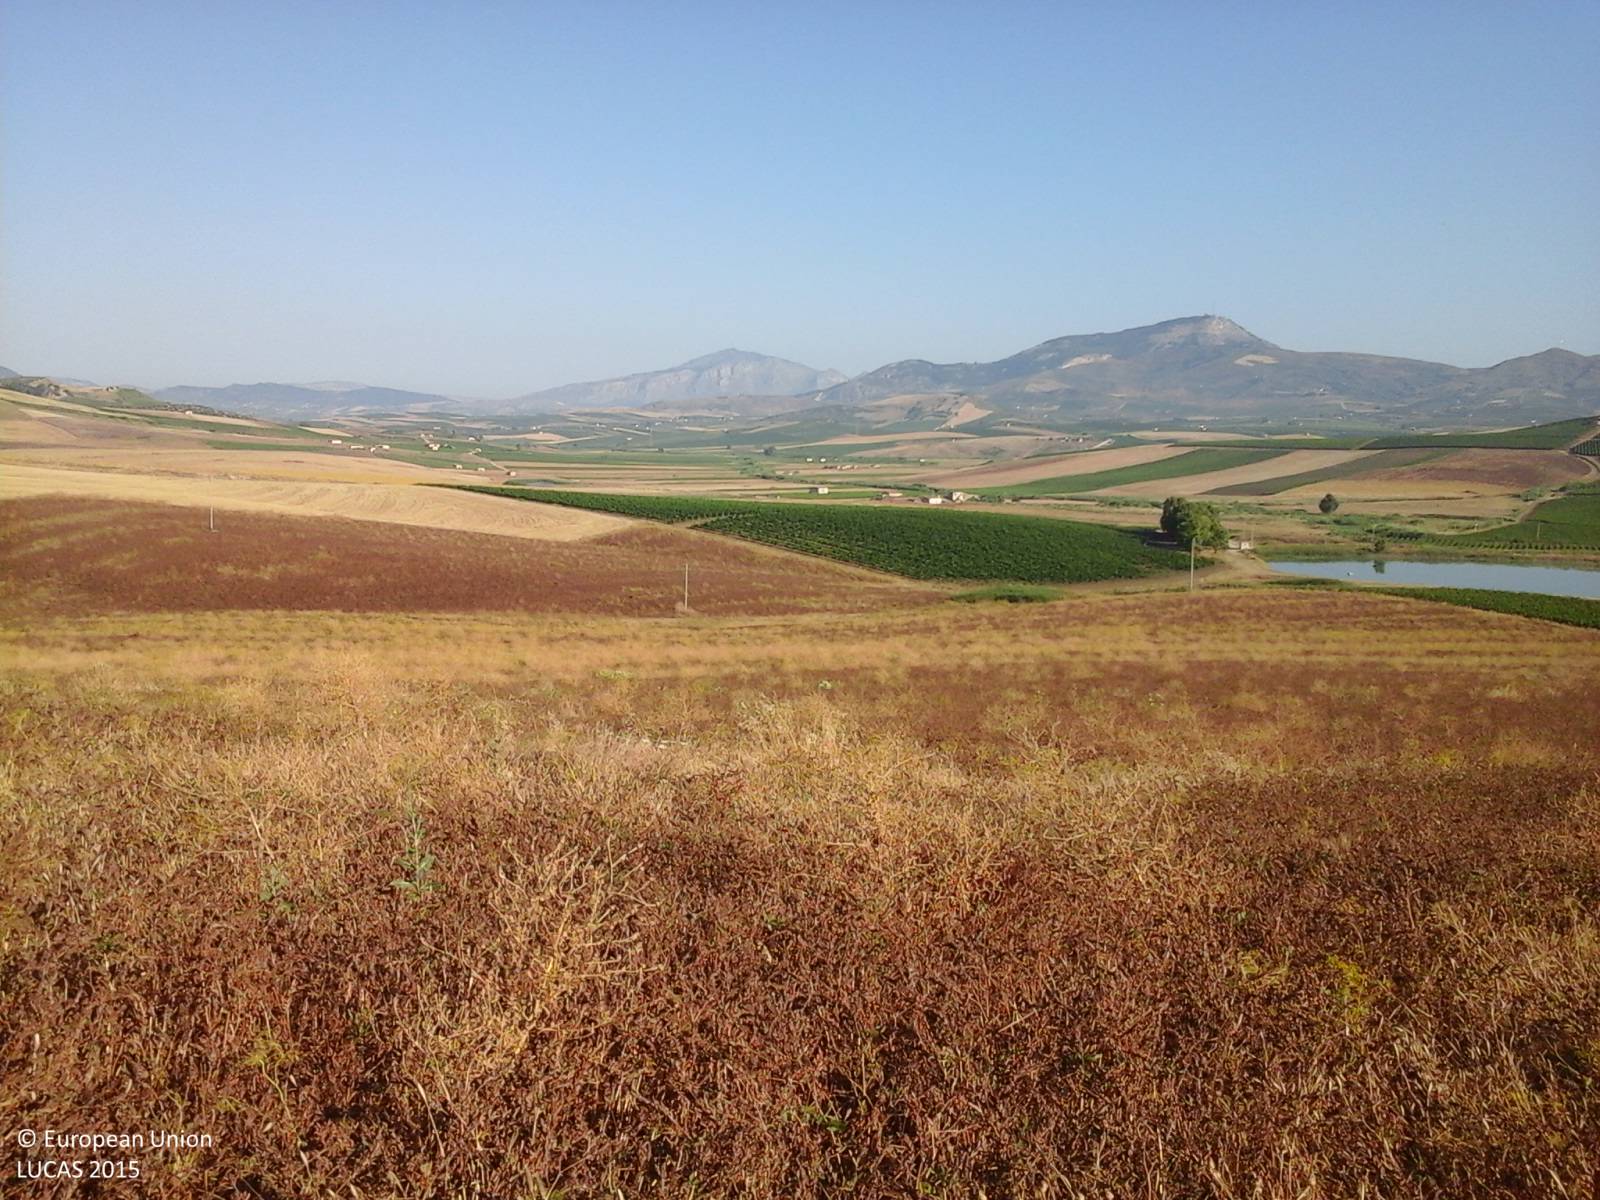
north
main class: Cropland
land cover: Other leguminous and mixtures for fodder
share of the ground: > 75 %
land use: Agriculture (excluding fallow land and kitchen gardens)
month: July
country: IT
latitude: 37.8814
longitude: 13.0137
